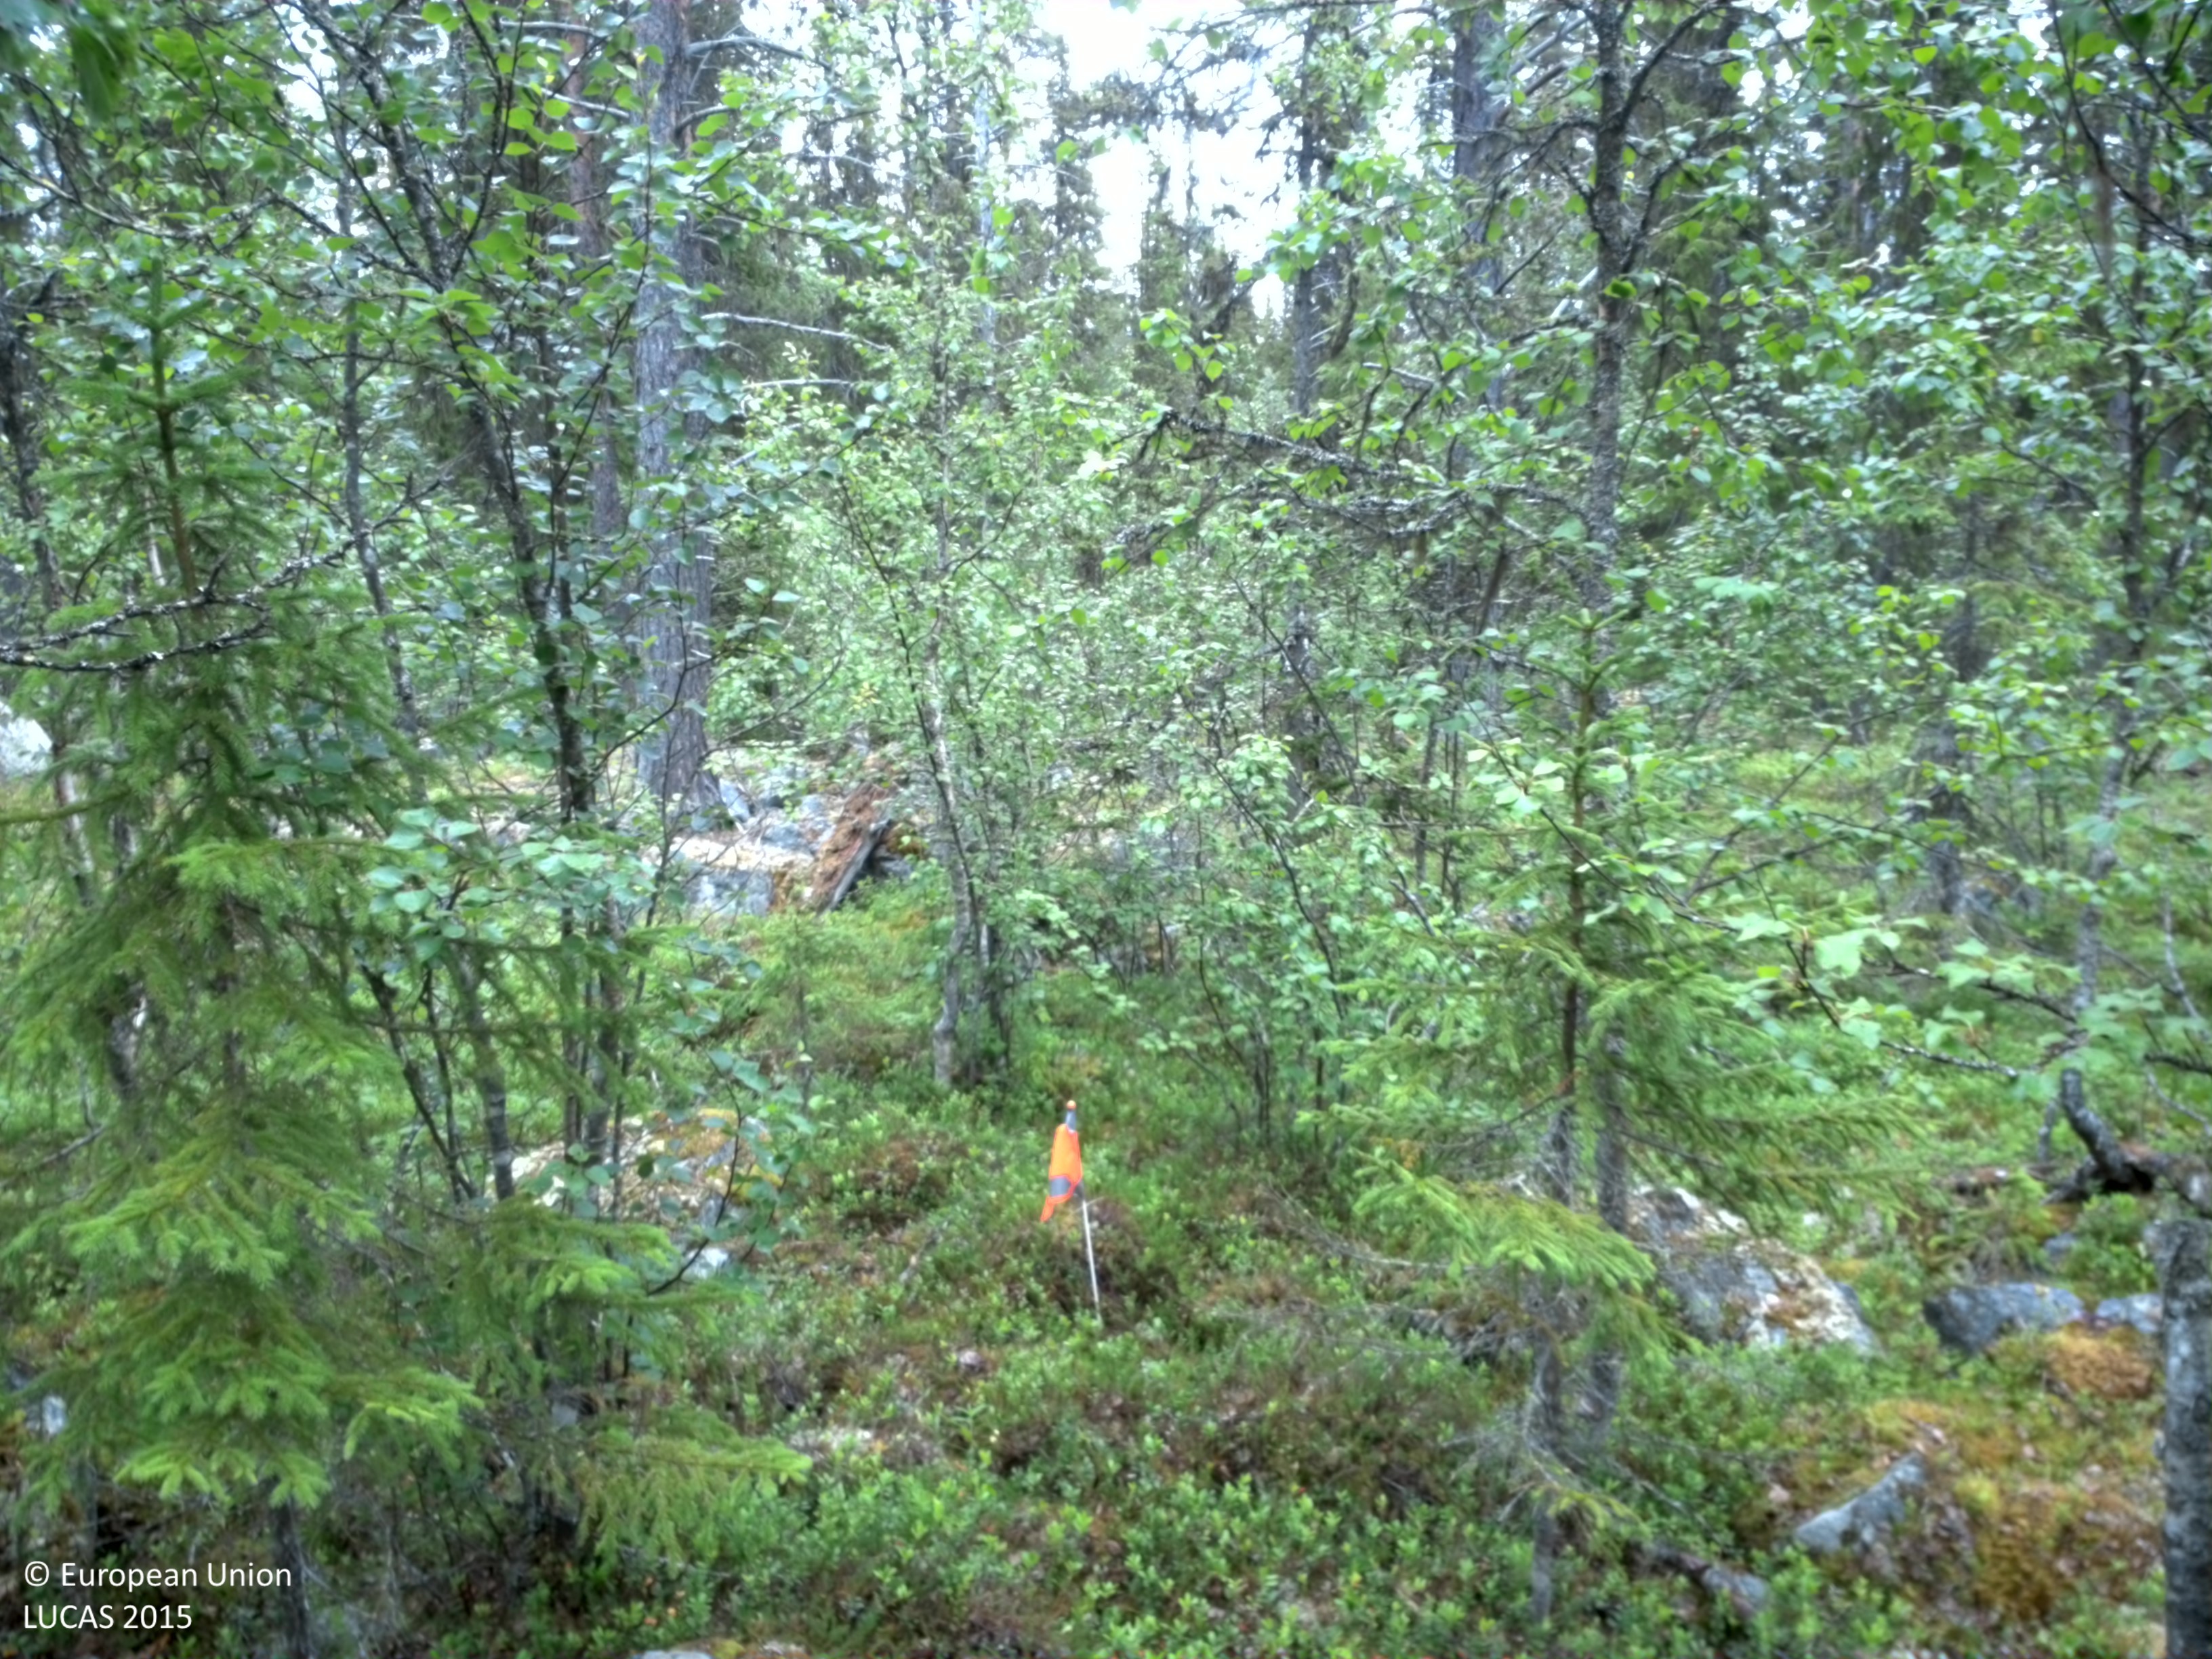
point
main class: Woodland
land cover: Pine dominated mixed woodland
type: boreal forest
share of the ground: 25 - 50 %
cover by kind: shrubs 40 %, broadleaved forest trees 25 %, lichens and mosses 20 %, coniferous forest trees 15 %
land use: Forestry
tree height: > 5 m
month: August
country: SE
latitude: 65.0403
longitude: 16.1457
